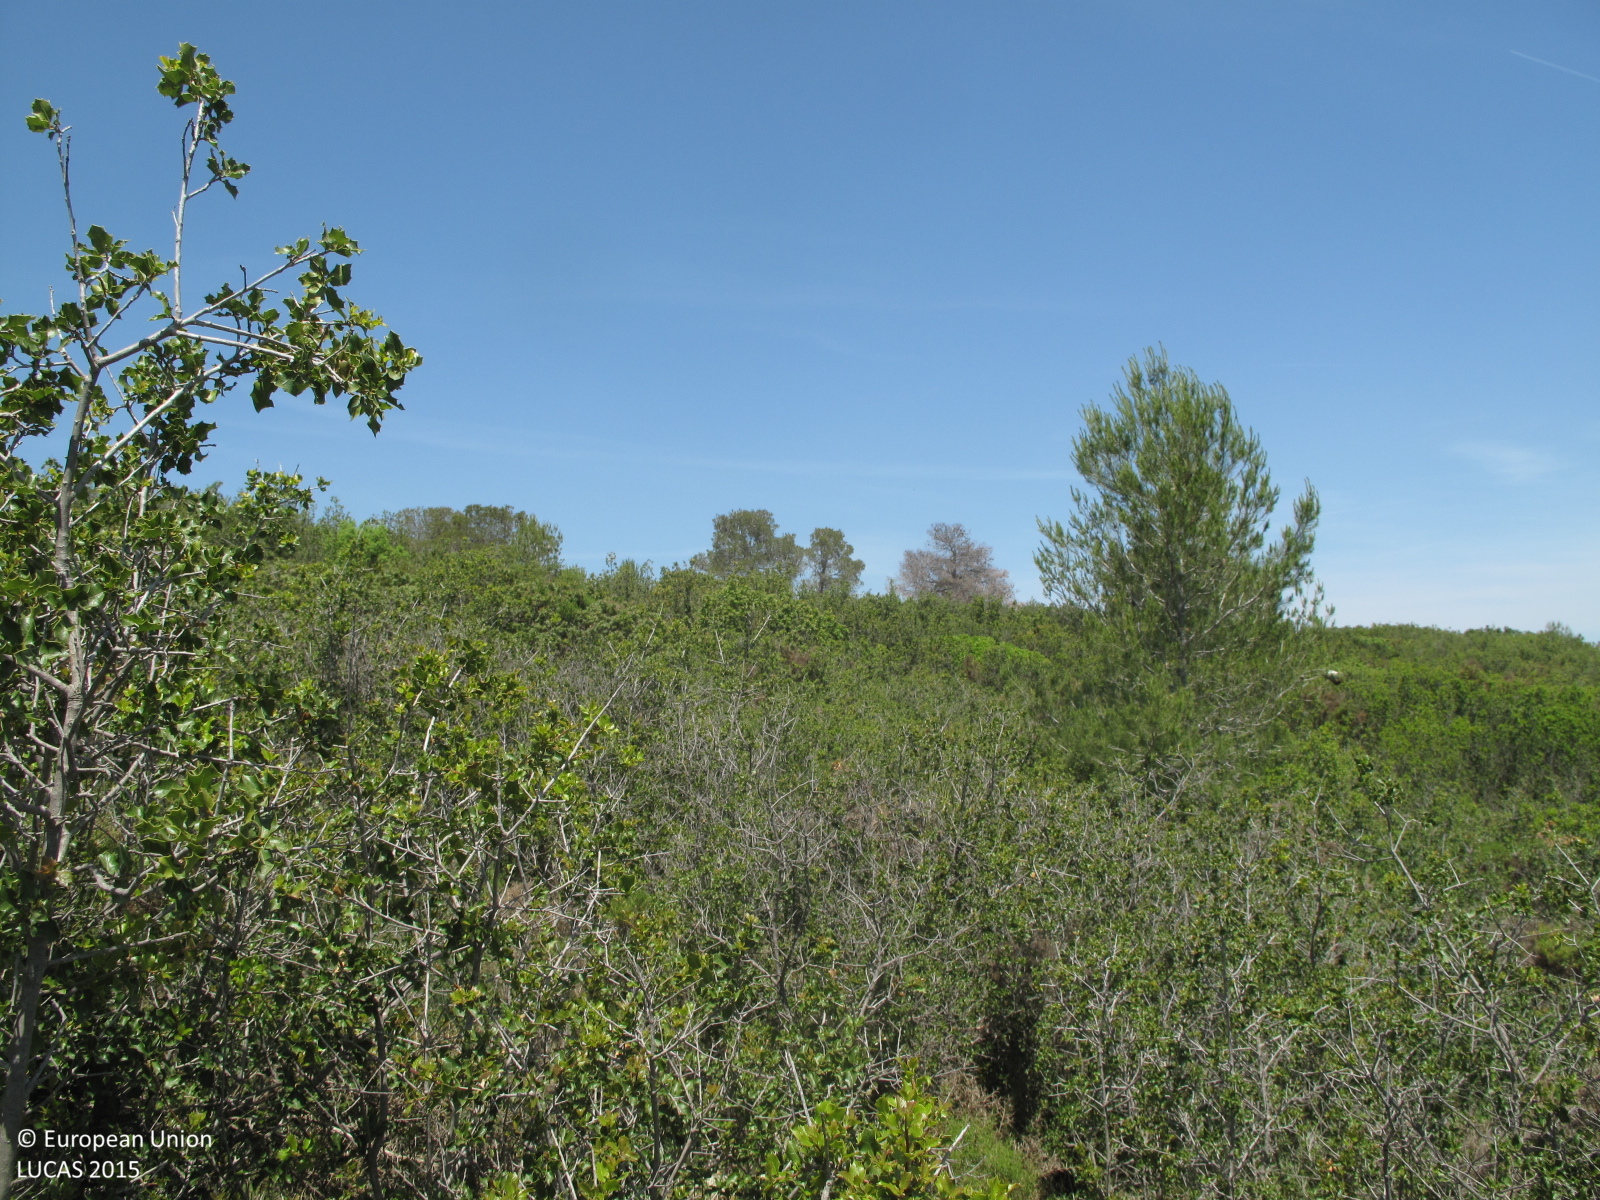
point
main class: Shrubland
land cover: Shrubland with sparse tree cover
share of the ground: > 75 %
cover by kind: shrubs 80 %, consolidated bare surface 15 %, broadleaved forest trees 5 %
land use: Semi-natural and natural areas not in use
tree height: < 5 m
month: May
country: ES
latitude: 38.9467
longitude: -0.7351
